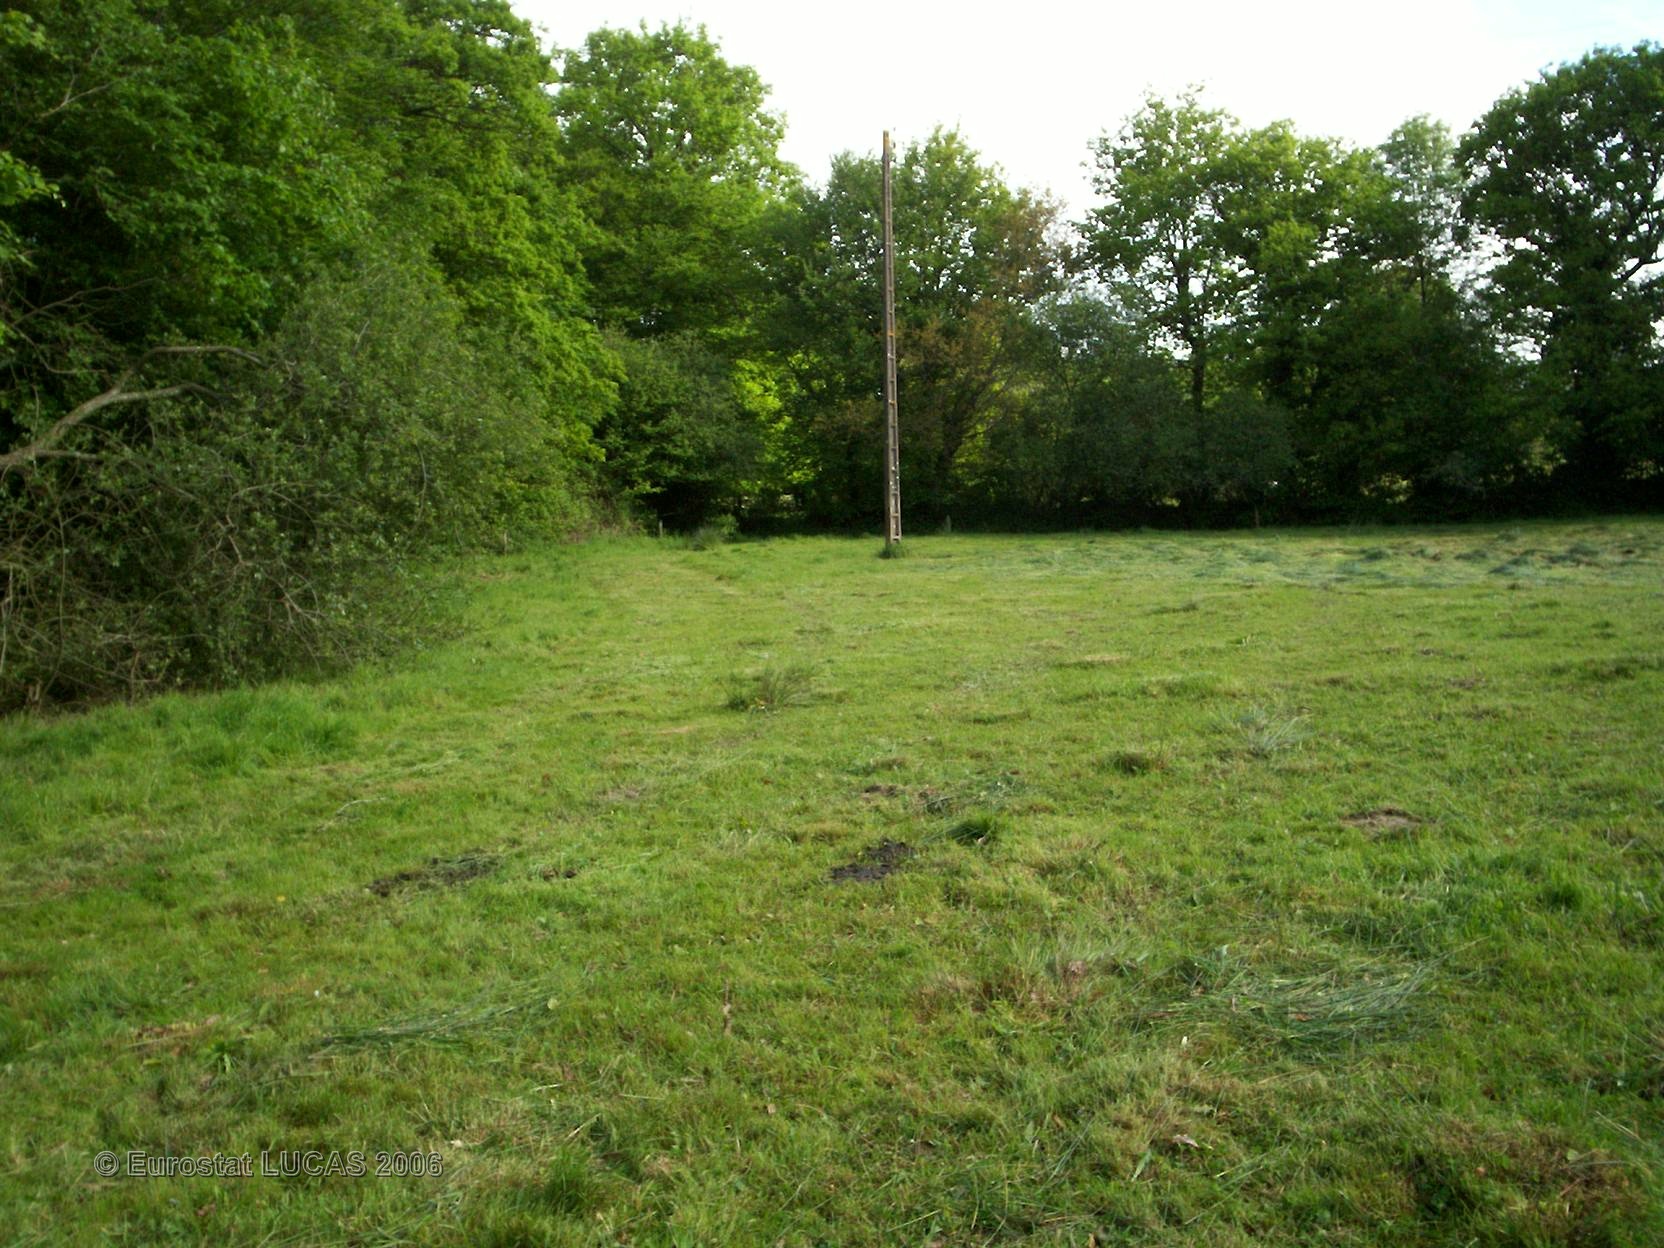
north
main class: Grassland
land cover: Grassland without tree/shrub cover
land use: Agriculture (excluding fallow land and kitchen gardens)
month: May
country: FR
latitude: 48.2888
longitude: -2.9942
